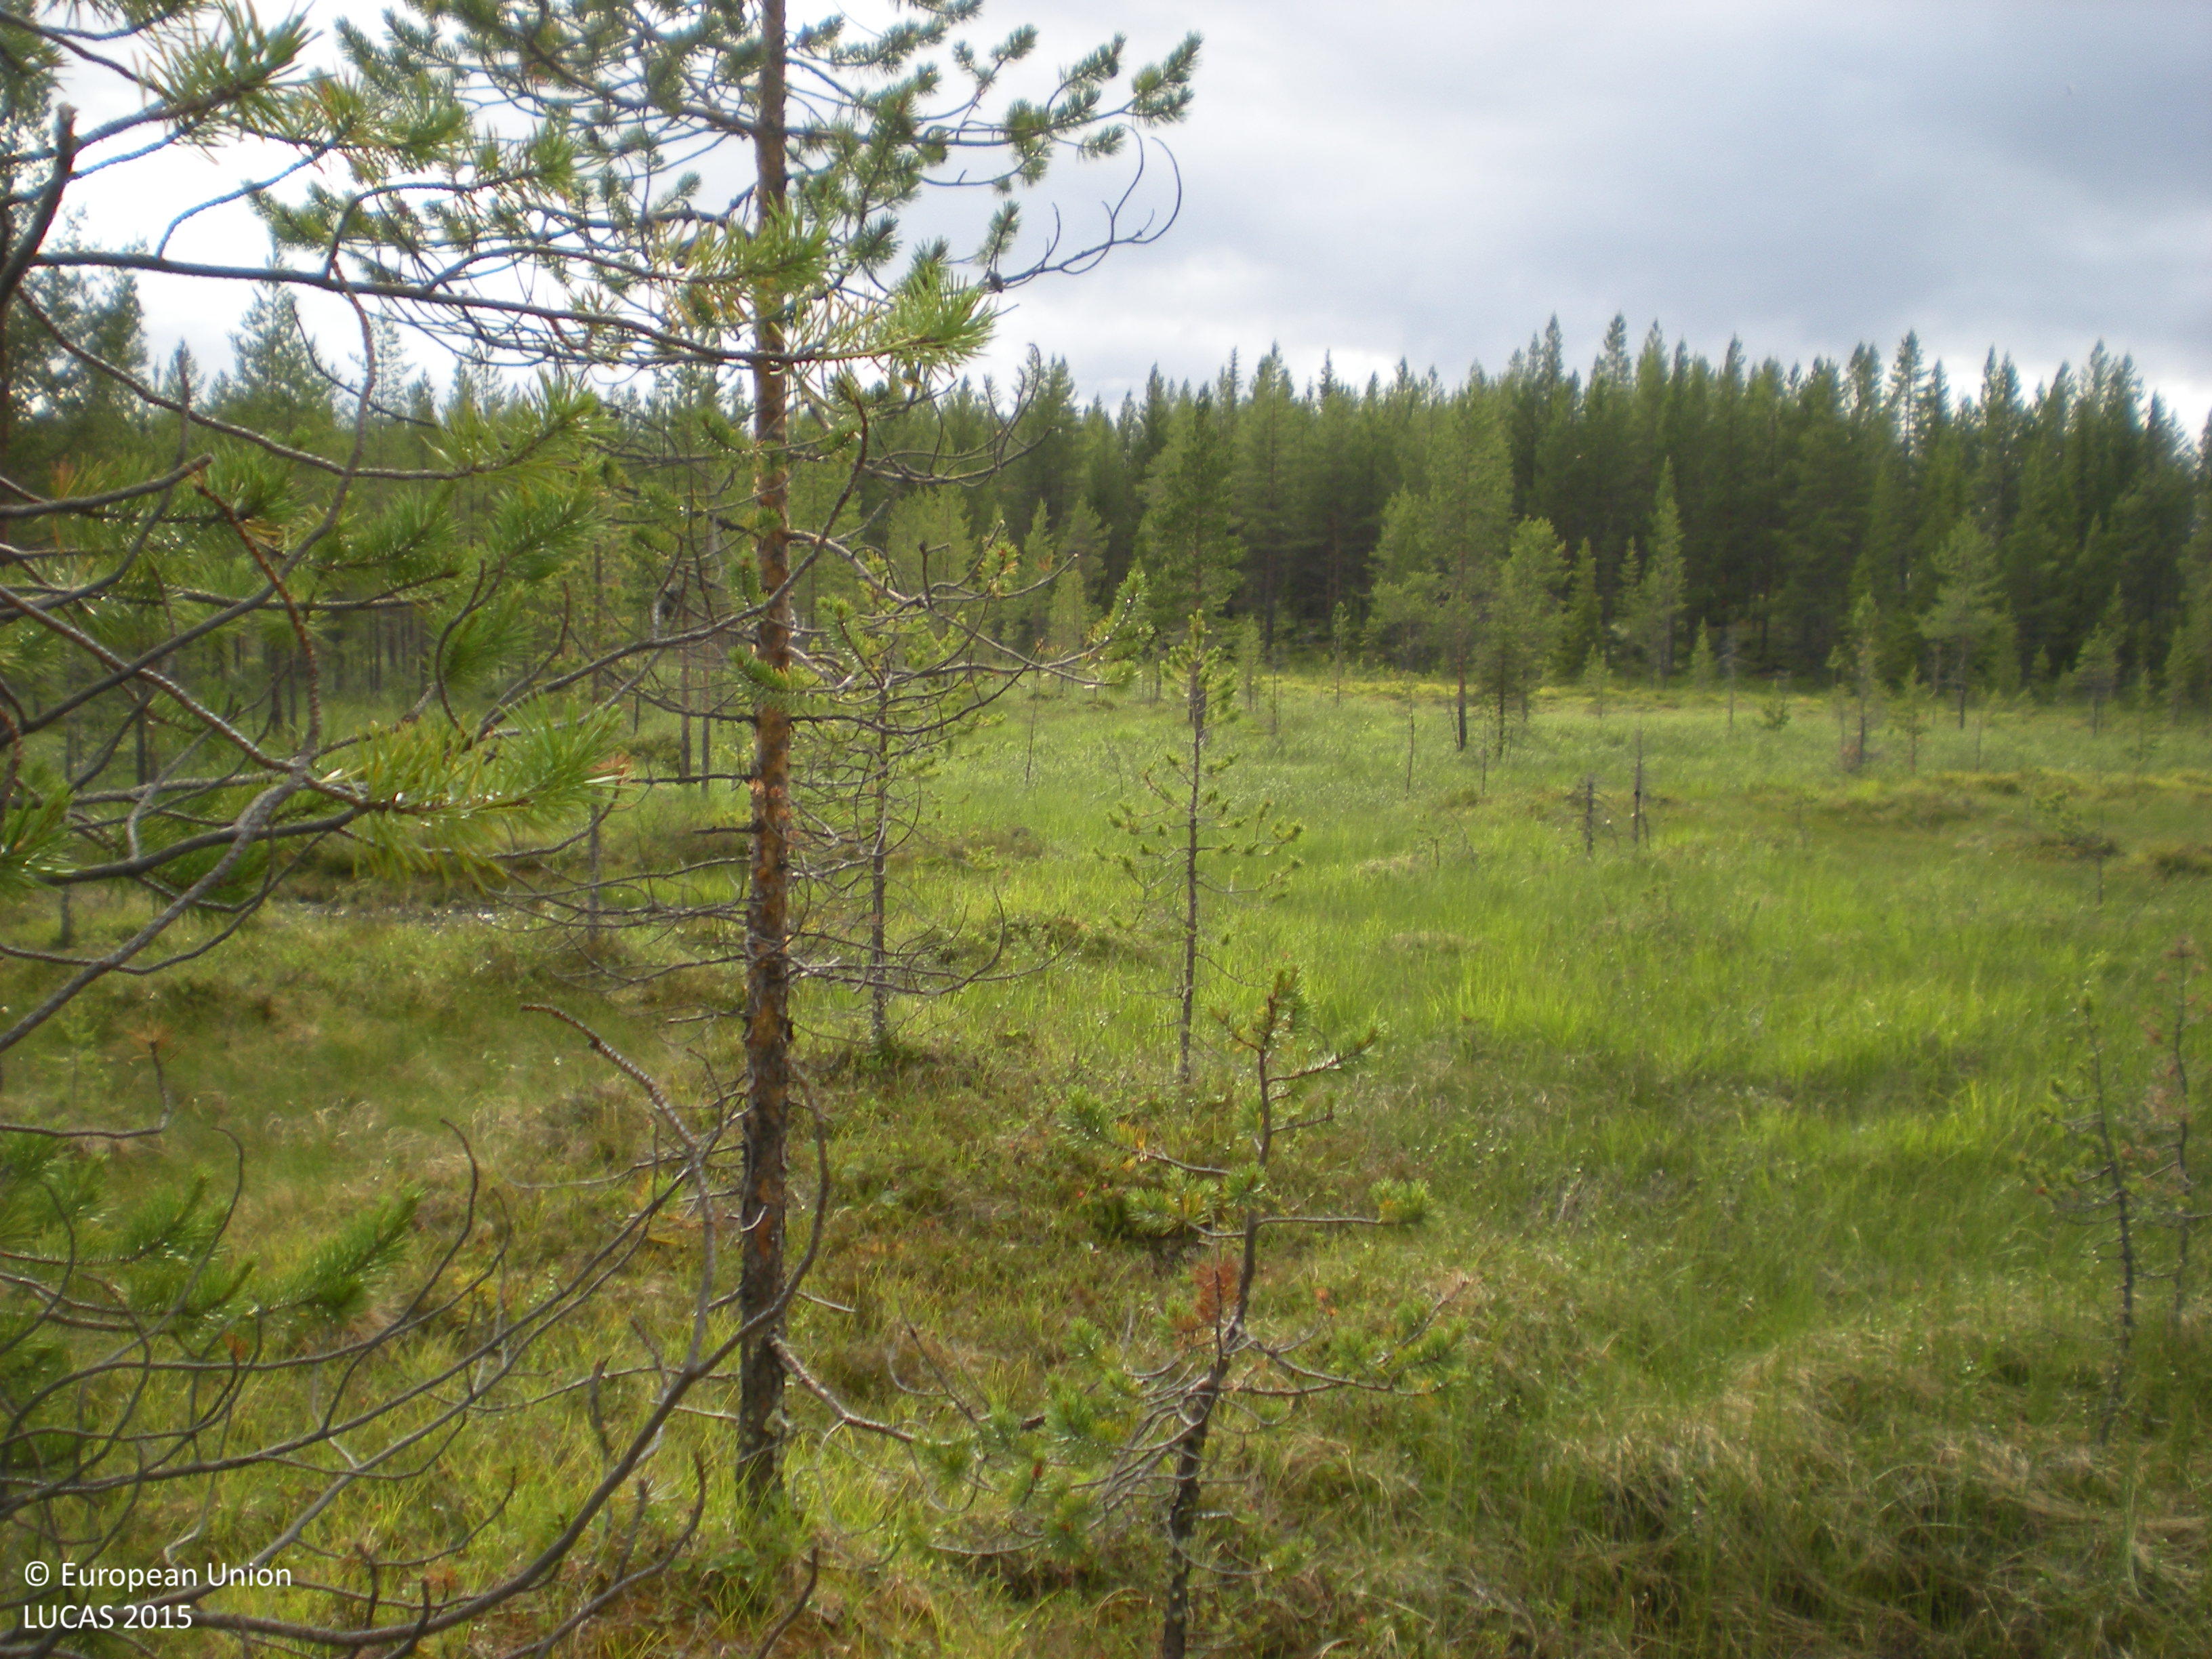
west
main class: Woodland
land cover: Pine dominated coniferous woodland
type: mire and swamp forests
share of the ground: 25 - 50 %
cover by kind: shrubs 45 %, coniferous forest trees 30 %, herbaceous plants 15 %, lichens and mosses 10 %
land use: Forestry
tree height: < 5 m
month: July
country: SE
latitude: 65.9403
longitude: 18.0234
